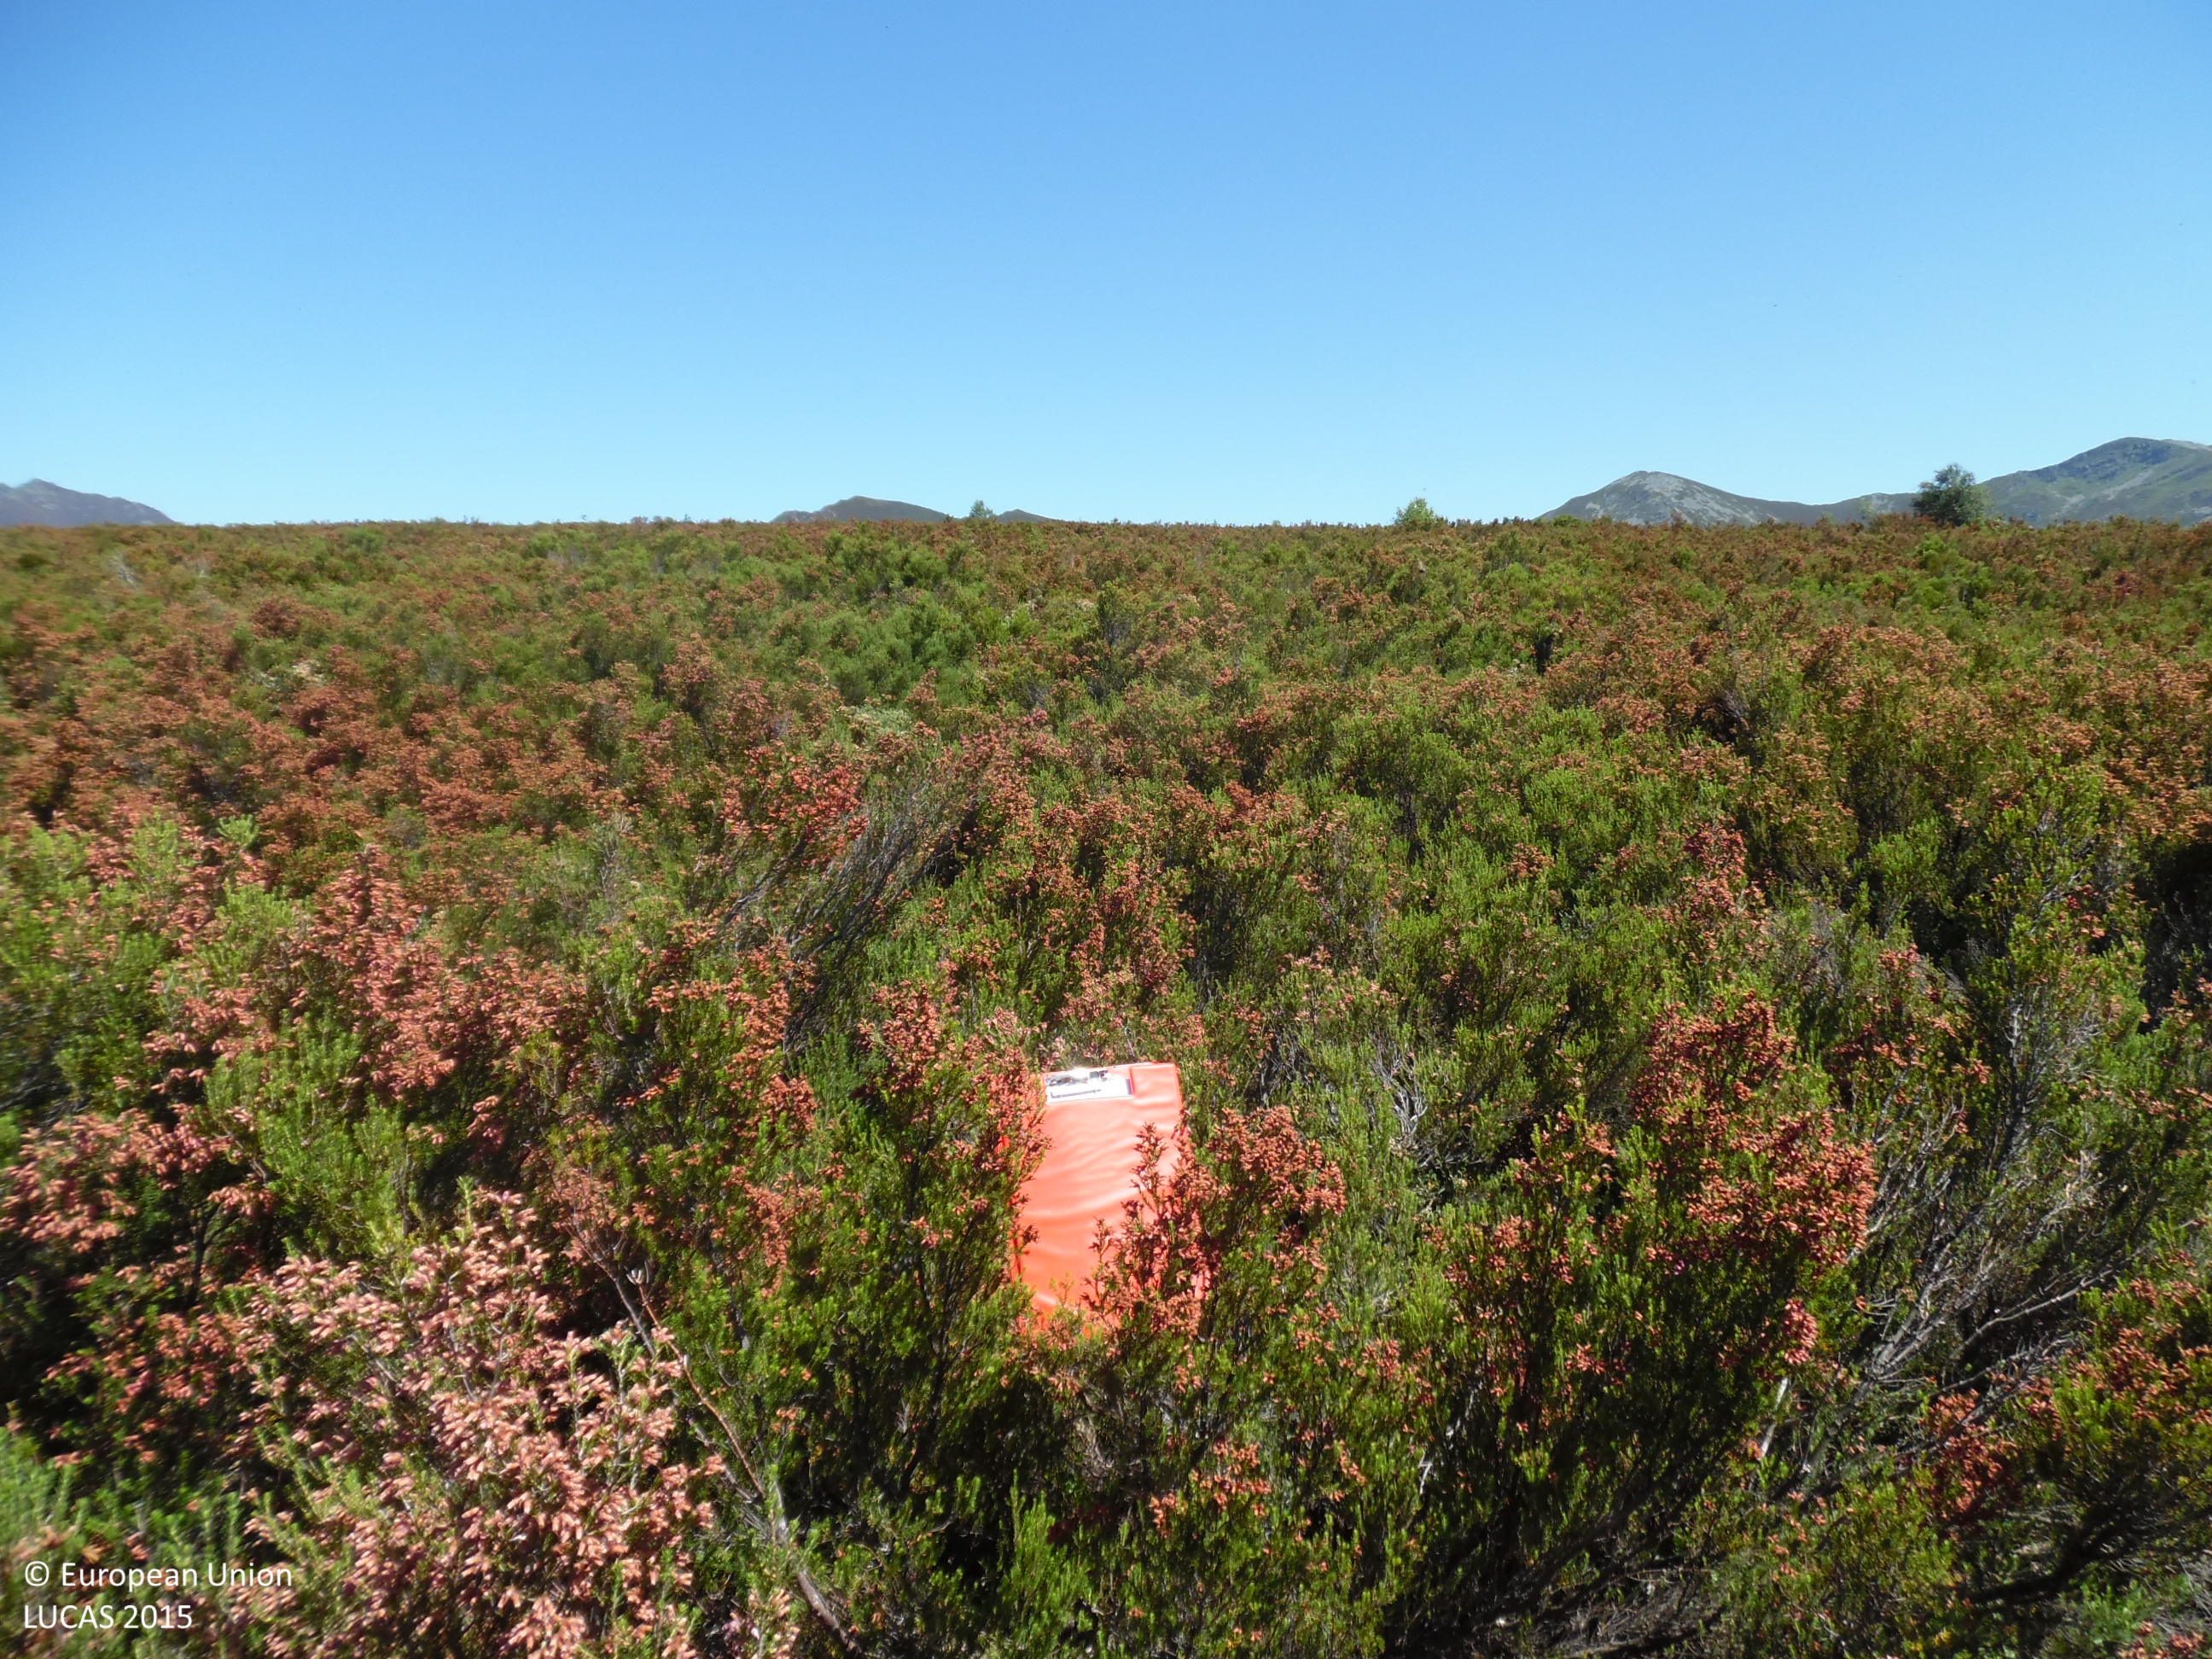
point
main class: Shrubland
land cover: Shrubland without tree cover
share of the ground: > 75 %
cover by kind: shrubs 95 %, herbaceous plants 5 %
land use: Semi-natural and natural areas not in use
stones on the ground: < 10 %
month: June
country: ES
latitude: 42.8879
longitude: -6.8440
